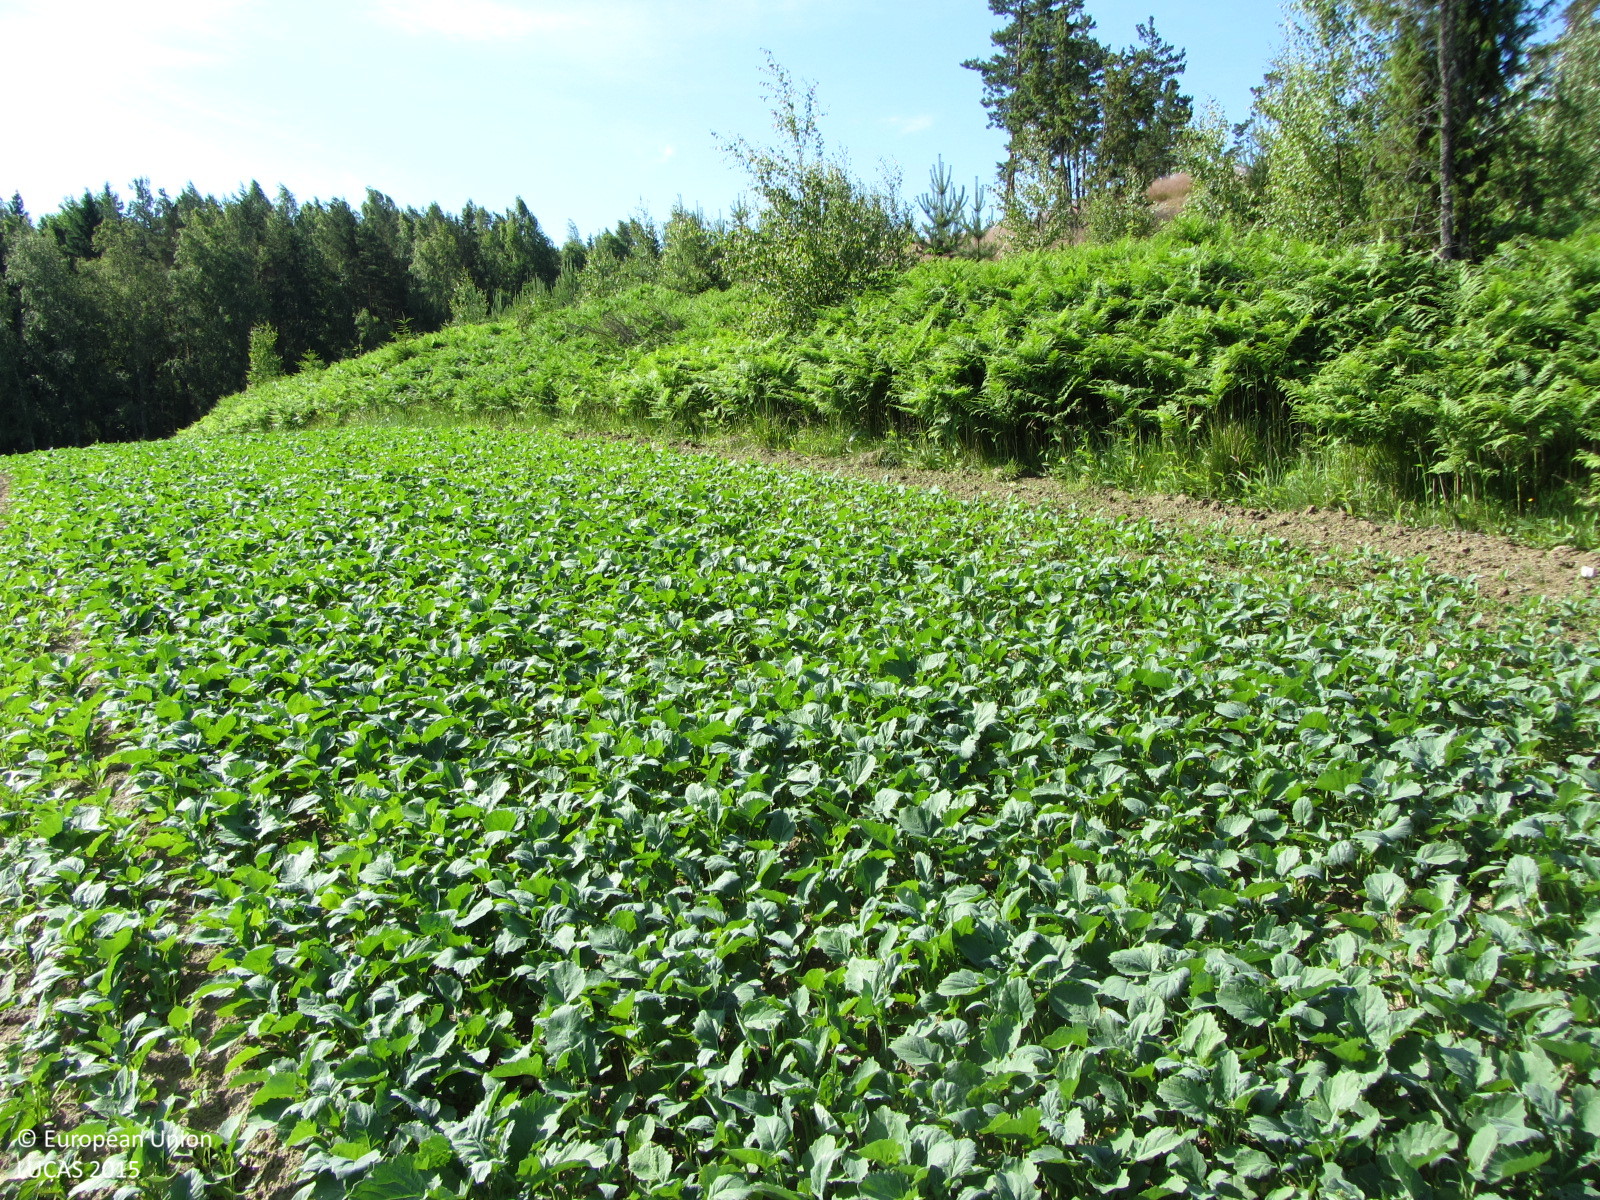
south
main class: Cropland
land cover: Other root crops
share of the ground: > 75 %
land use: Agriculture (excluding fallow land and kitchen gardens)
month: July
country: FI
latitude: 60.0889
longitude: 23.3732
